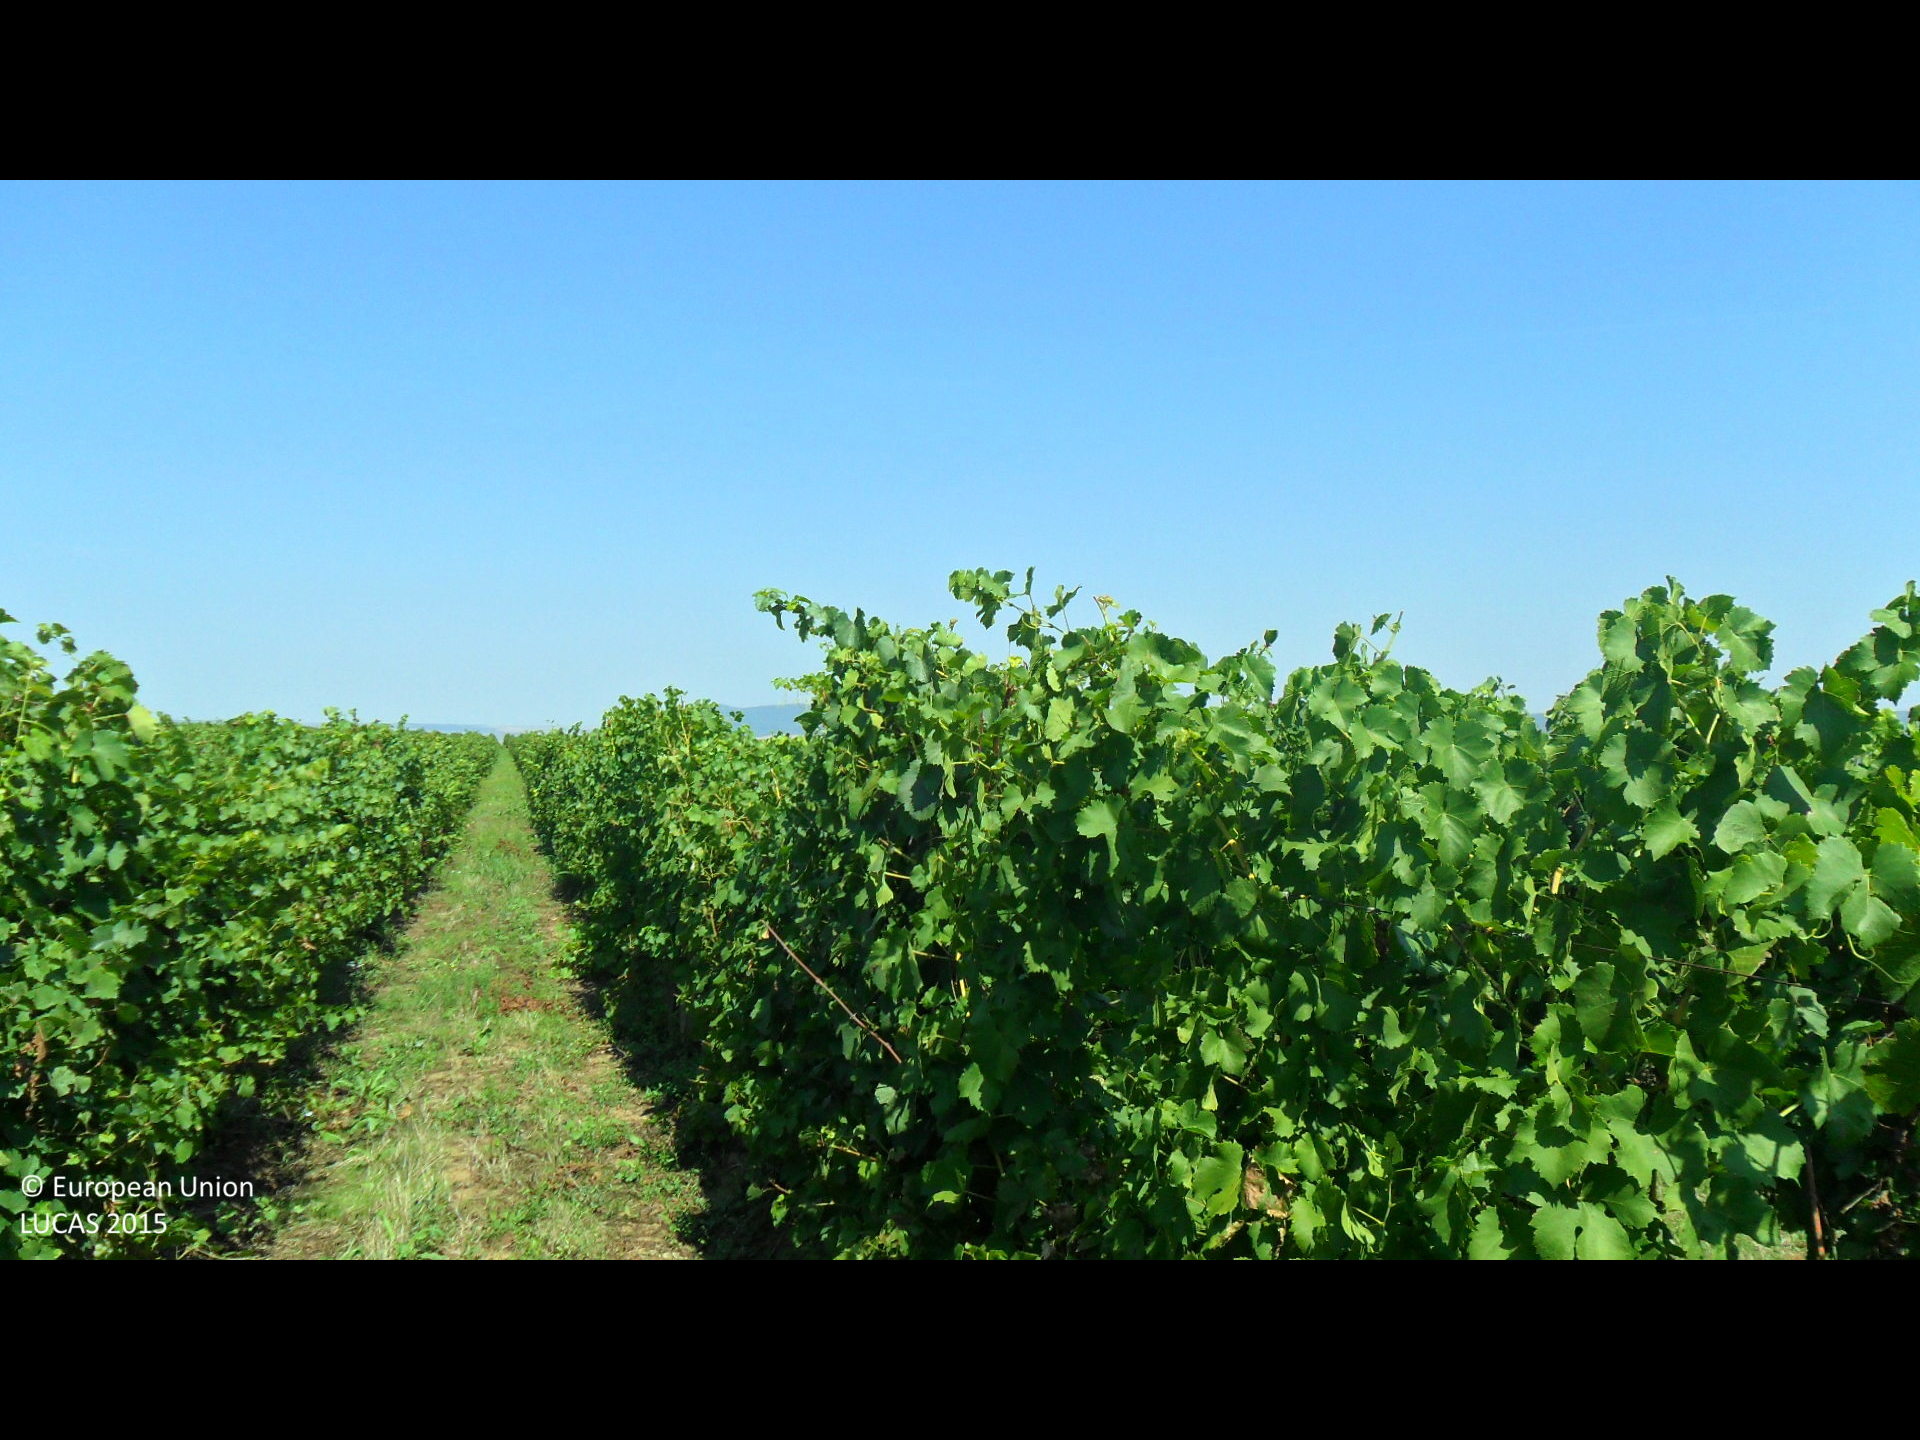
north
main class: Cropland
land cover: Vineyards
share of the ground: > 75 %
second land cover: Grassland without tree/shrub cover
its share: 25 - 50 %
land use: Agriculture (excluding fallow land and kitchen gardens)
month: August
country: BG
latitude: 43.2142
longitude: 26.7626
